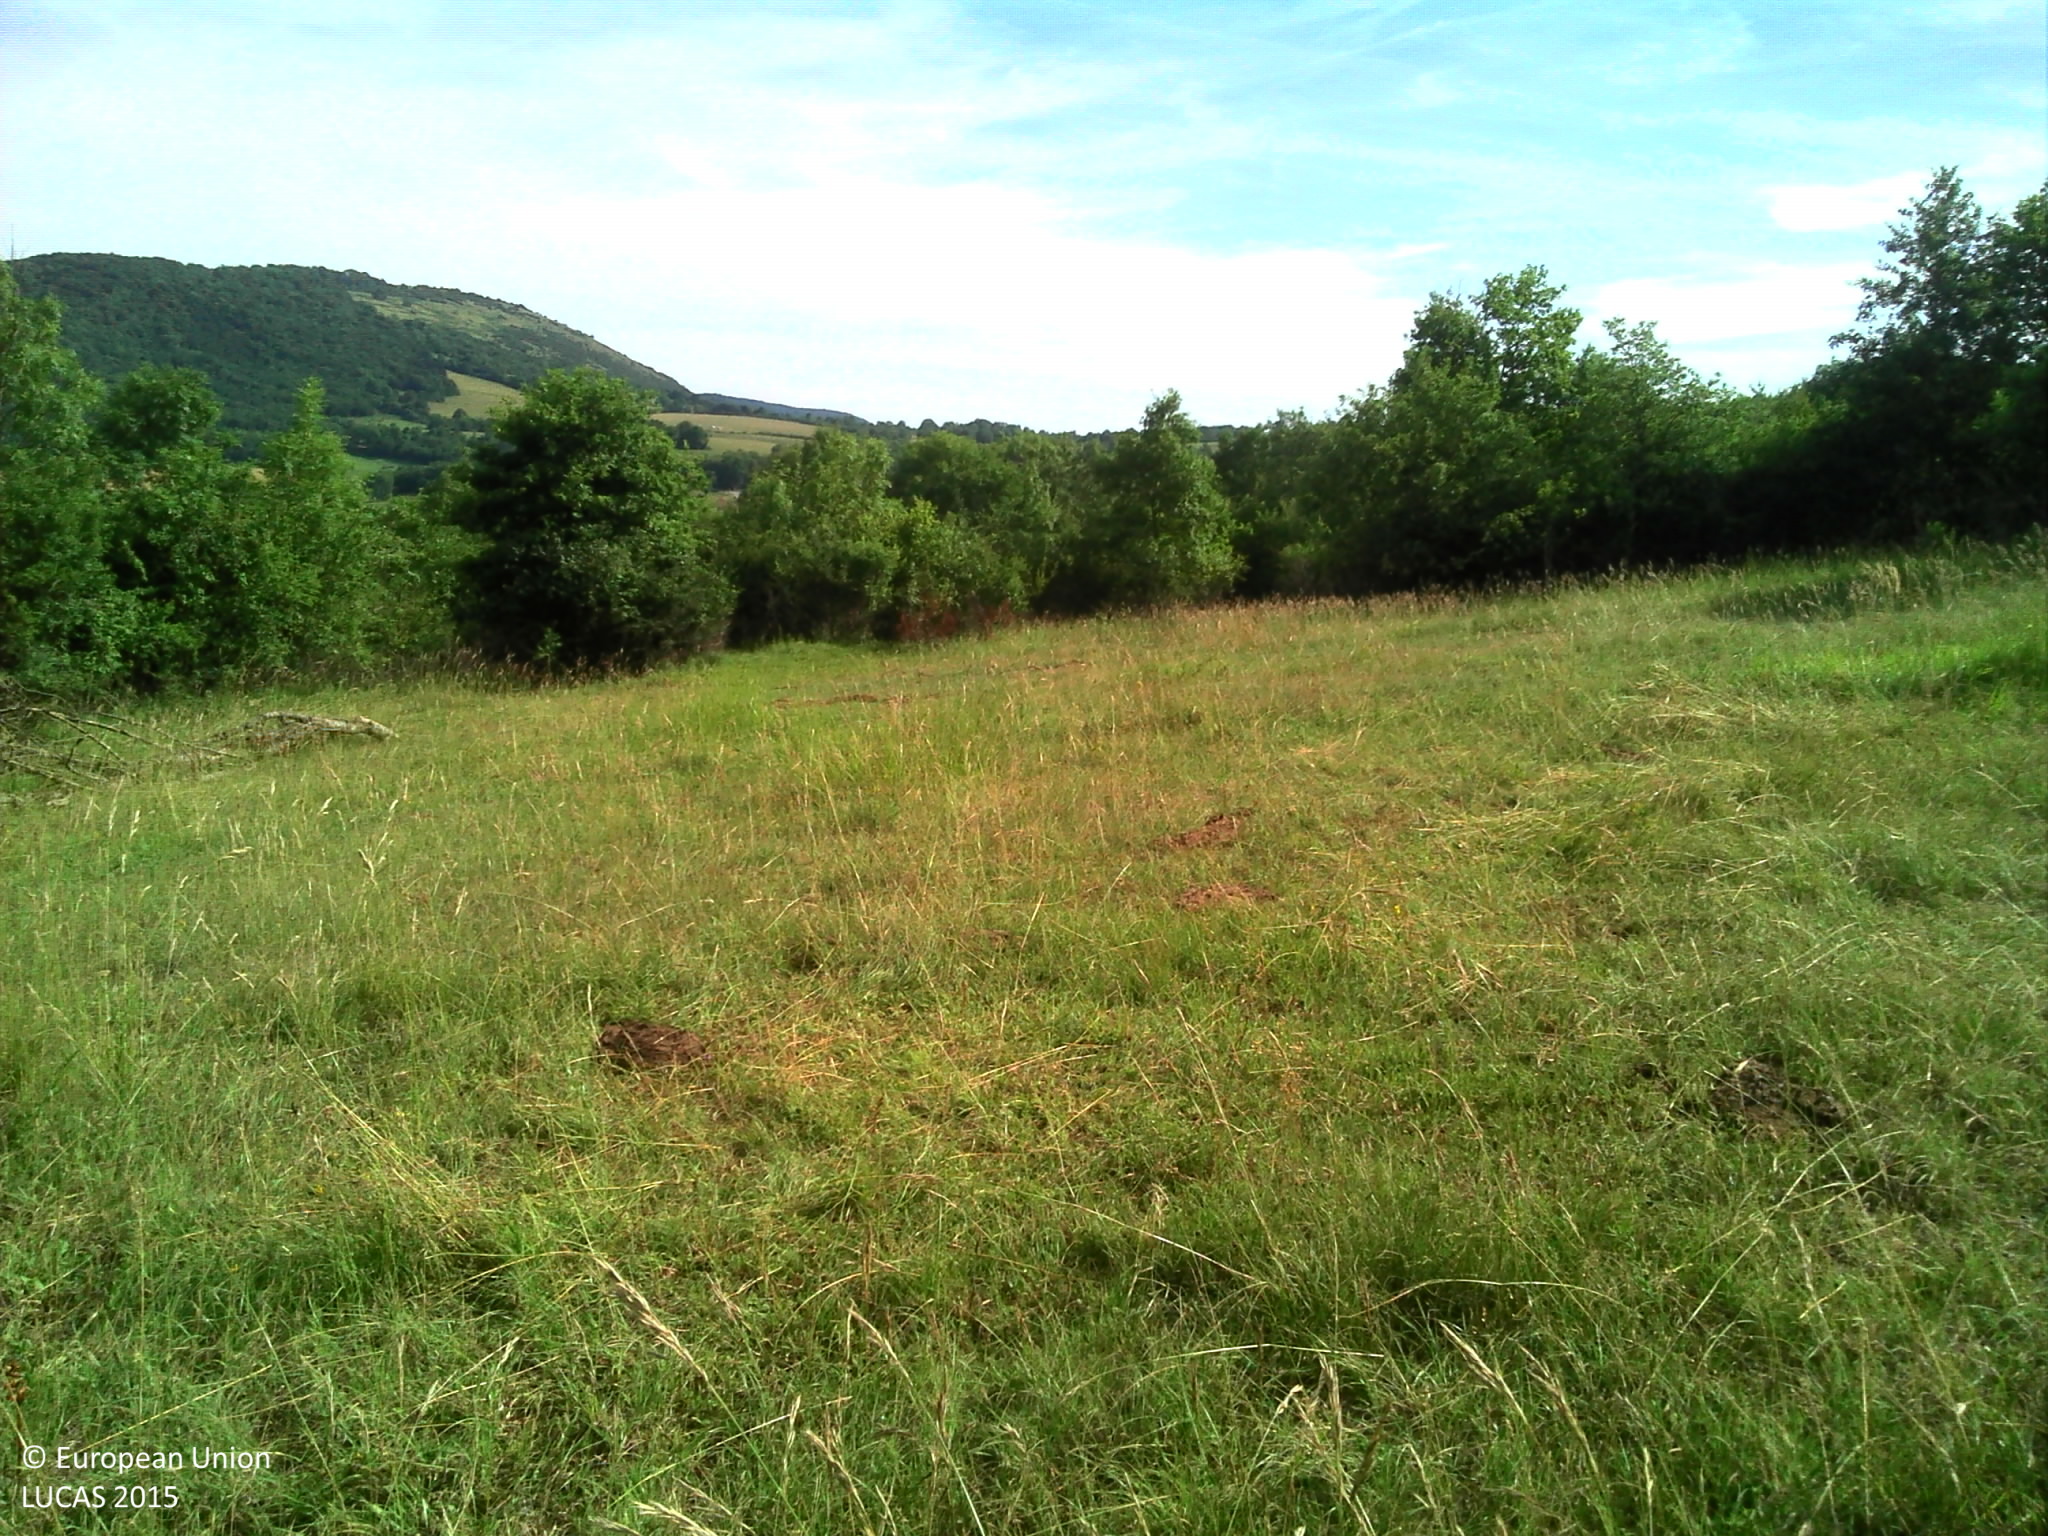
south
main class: Grassland
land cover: Grassland with sparse tree/shrub cover
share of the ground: > 75 %
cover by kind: herbaceous plants 95 %, broadleaved forest trees 5 %
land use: Agriculture (excluding fallow land and kitchen gardens)
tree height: < 5 m
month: June
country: FR
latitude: 46.3601
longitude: 5.3889
